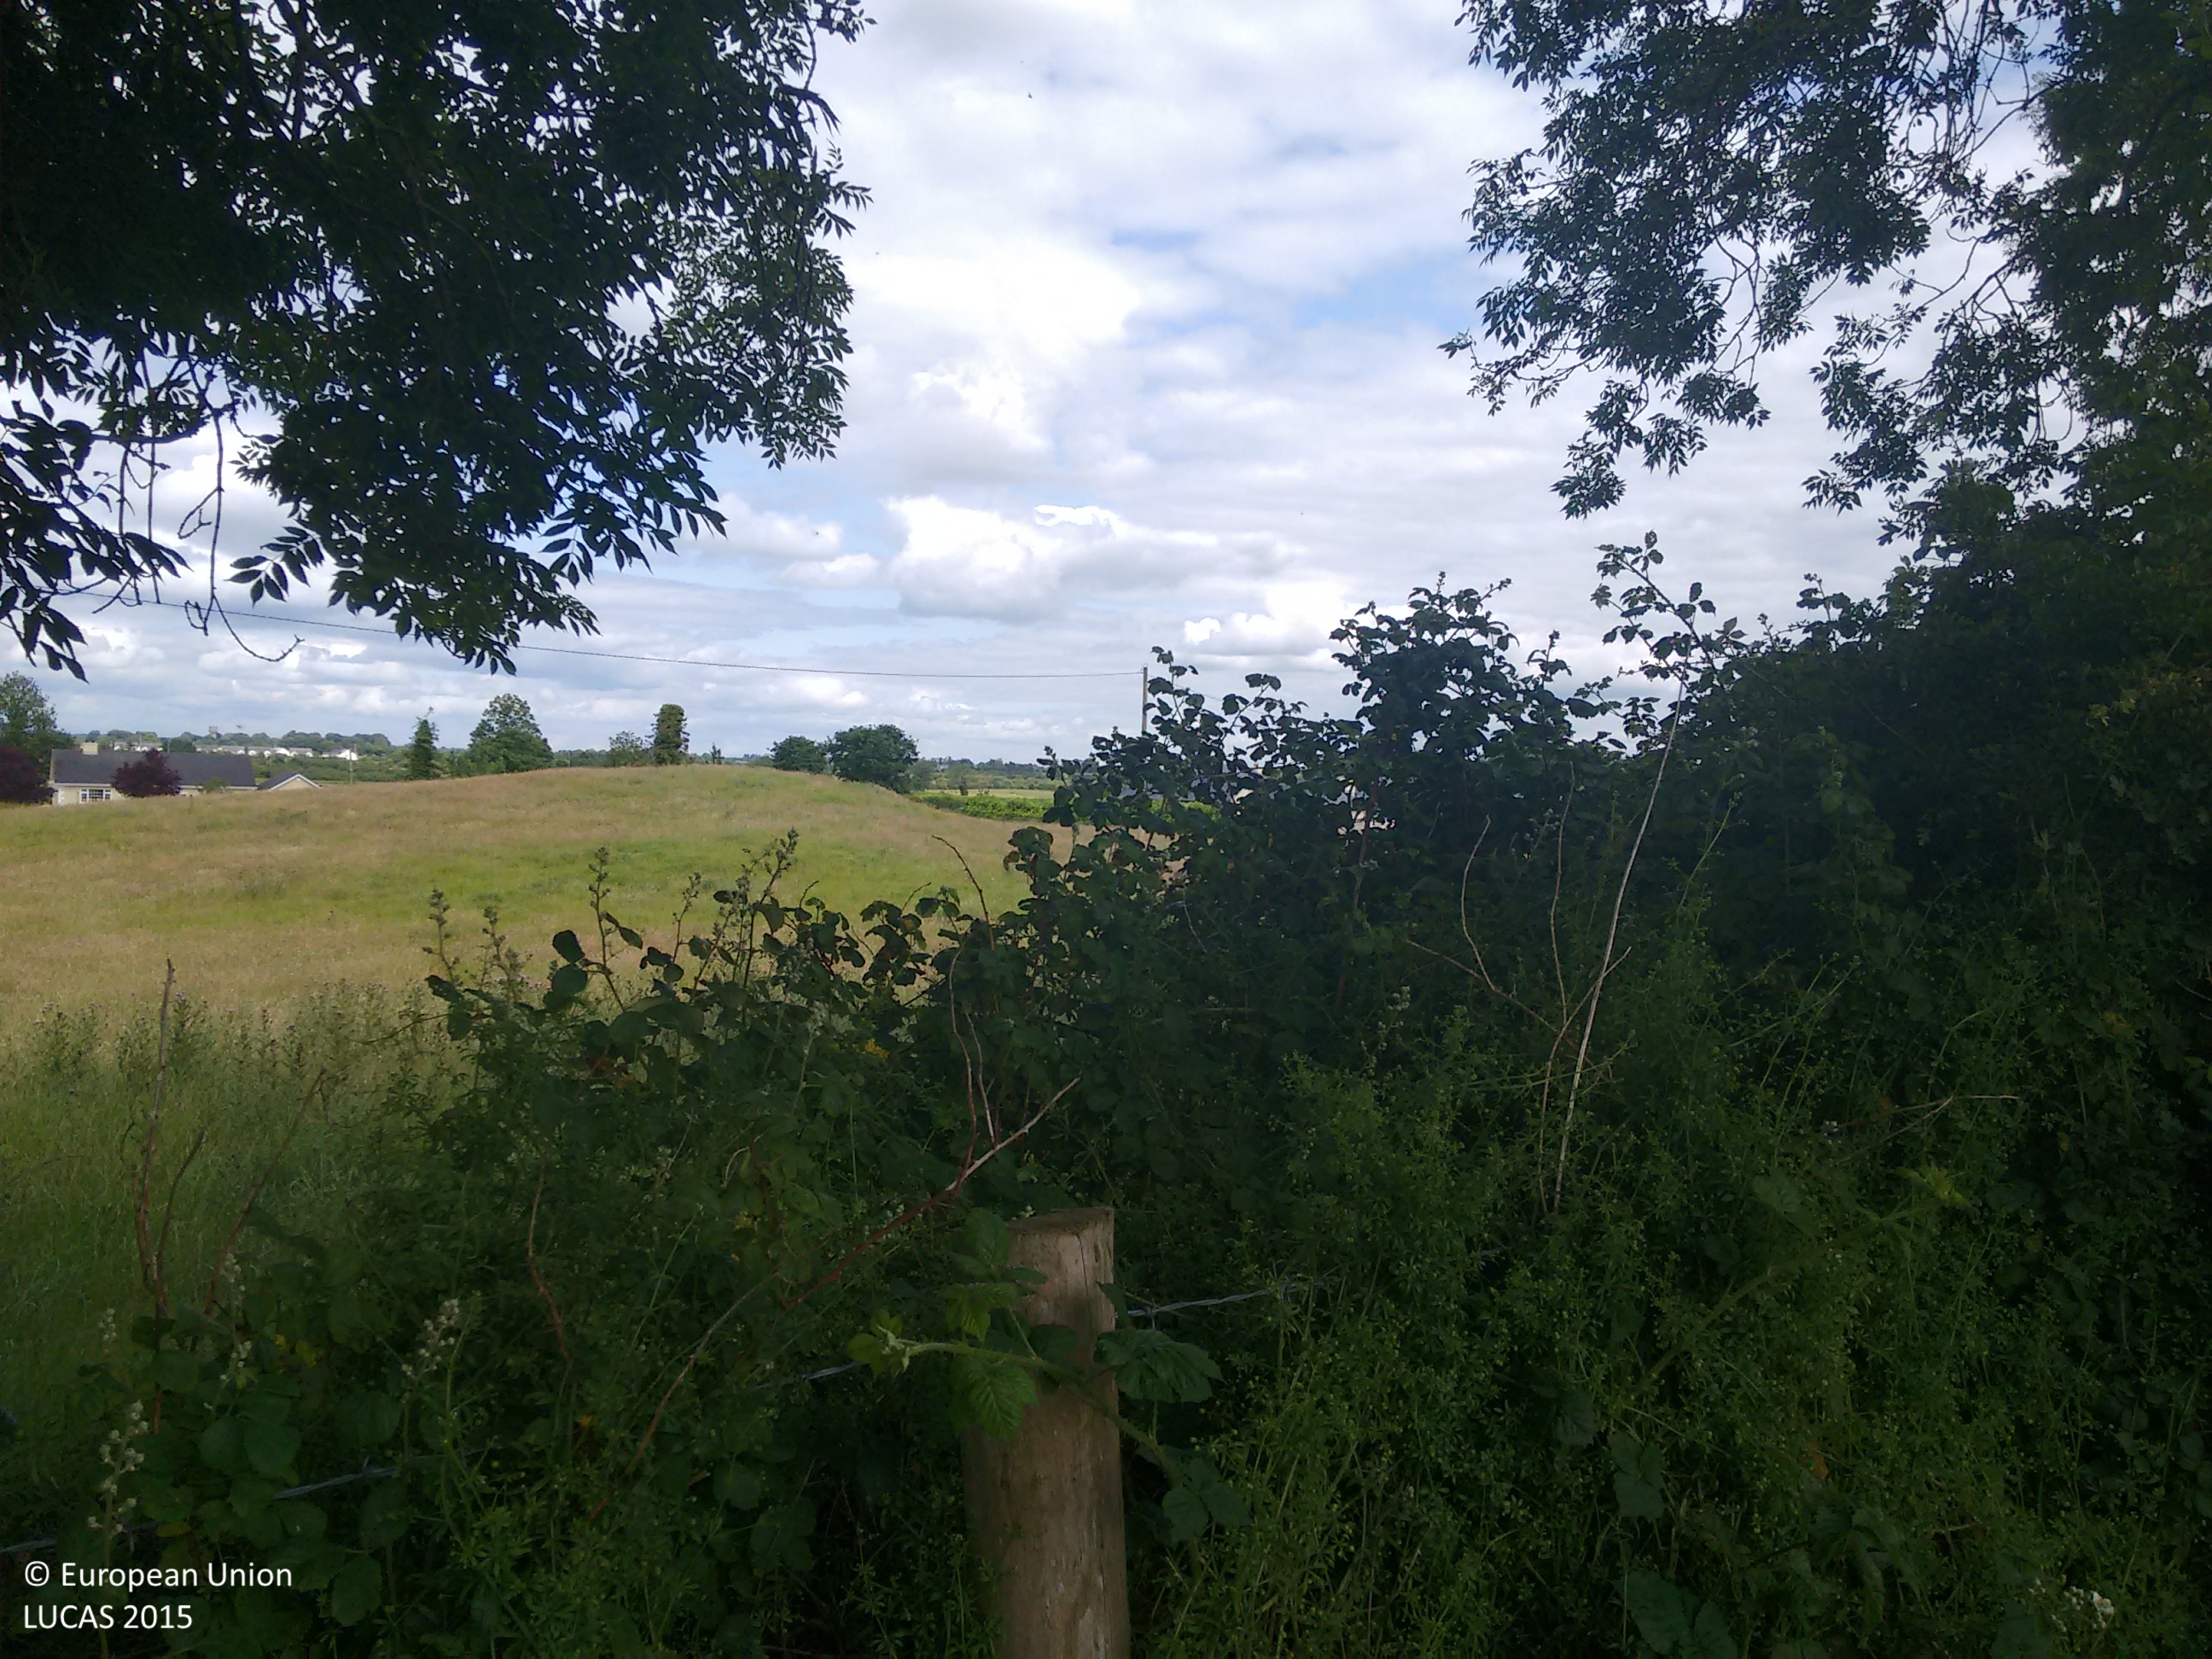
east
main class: Grassland
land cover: Grassland without tree/shrub cover
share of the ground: > 75 %
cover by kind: herbaceous plants 100 %
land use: Agriculture (excluding fallow land and kitchen gardens)
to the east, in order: Managed hedges; Fences; Grassland without tree/shrub cover; Fences; Dry stone walls; Managed hedges; Grassland without tree/shrub cover; Electric lines; Grassland without tree/shrub cover; Managed hedges; Artificial constructions in urban areas; Managed hedges; Grassland without tree/shrub cover
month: July
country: IE
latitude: 53.5458
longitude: -7.7794
